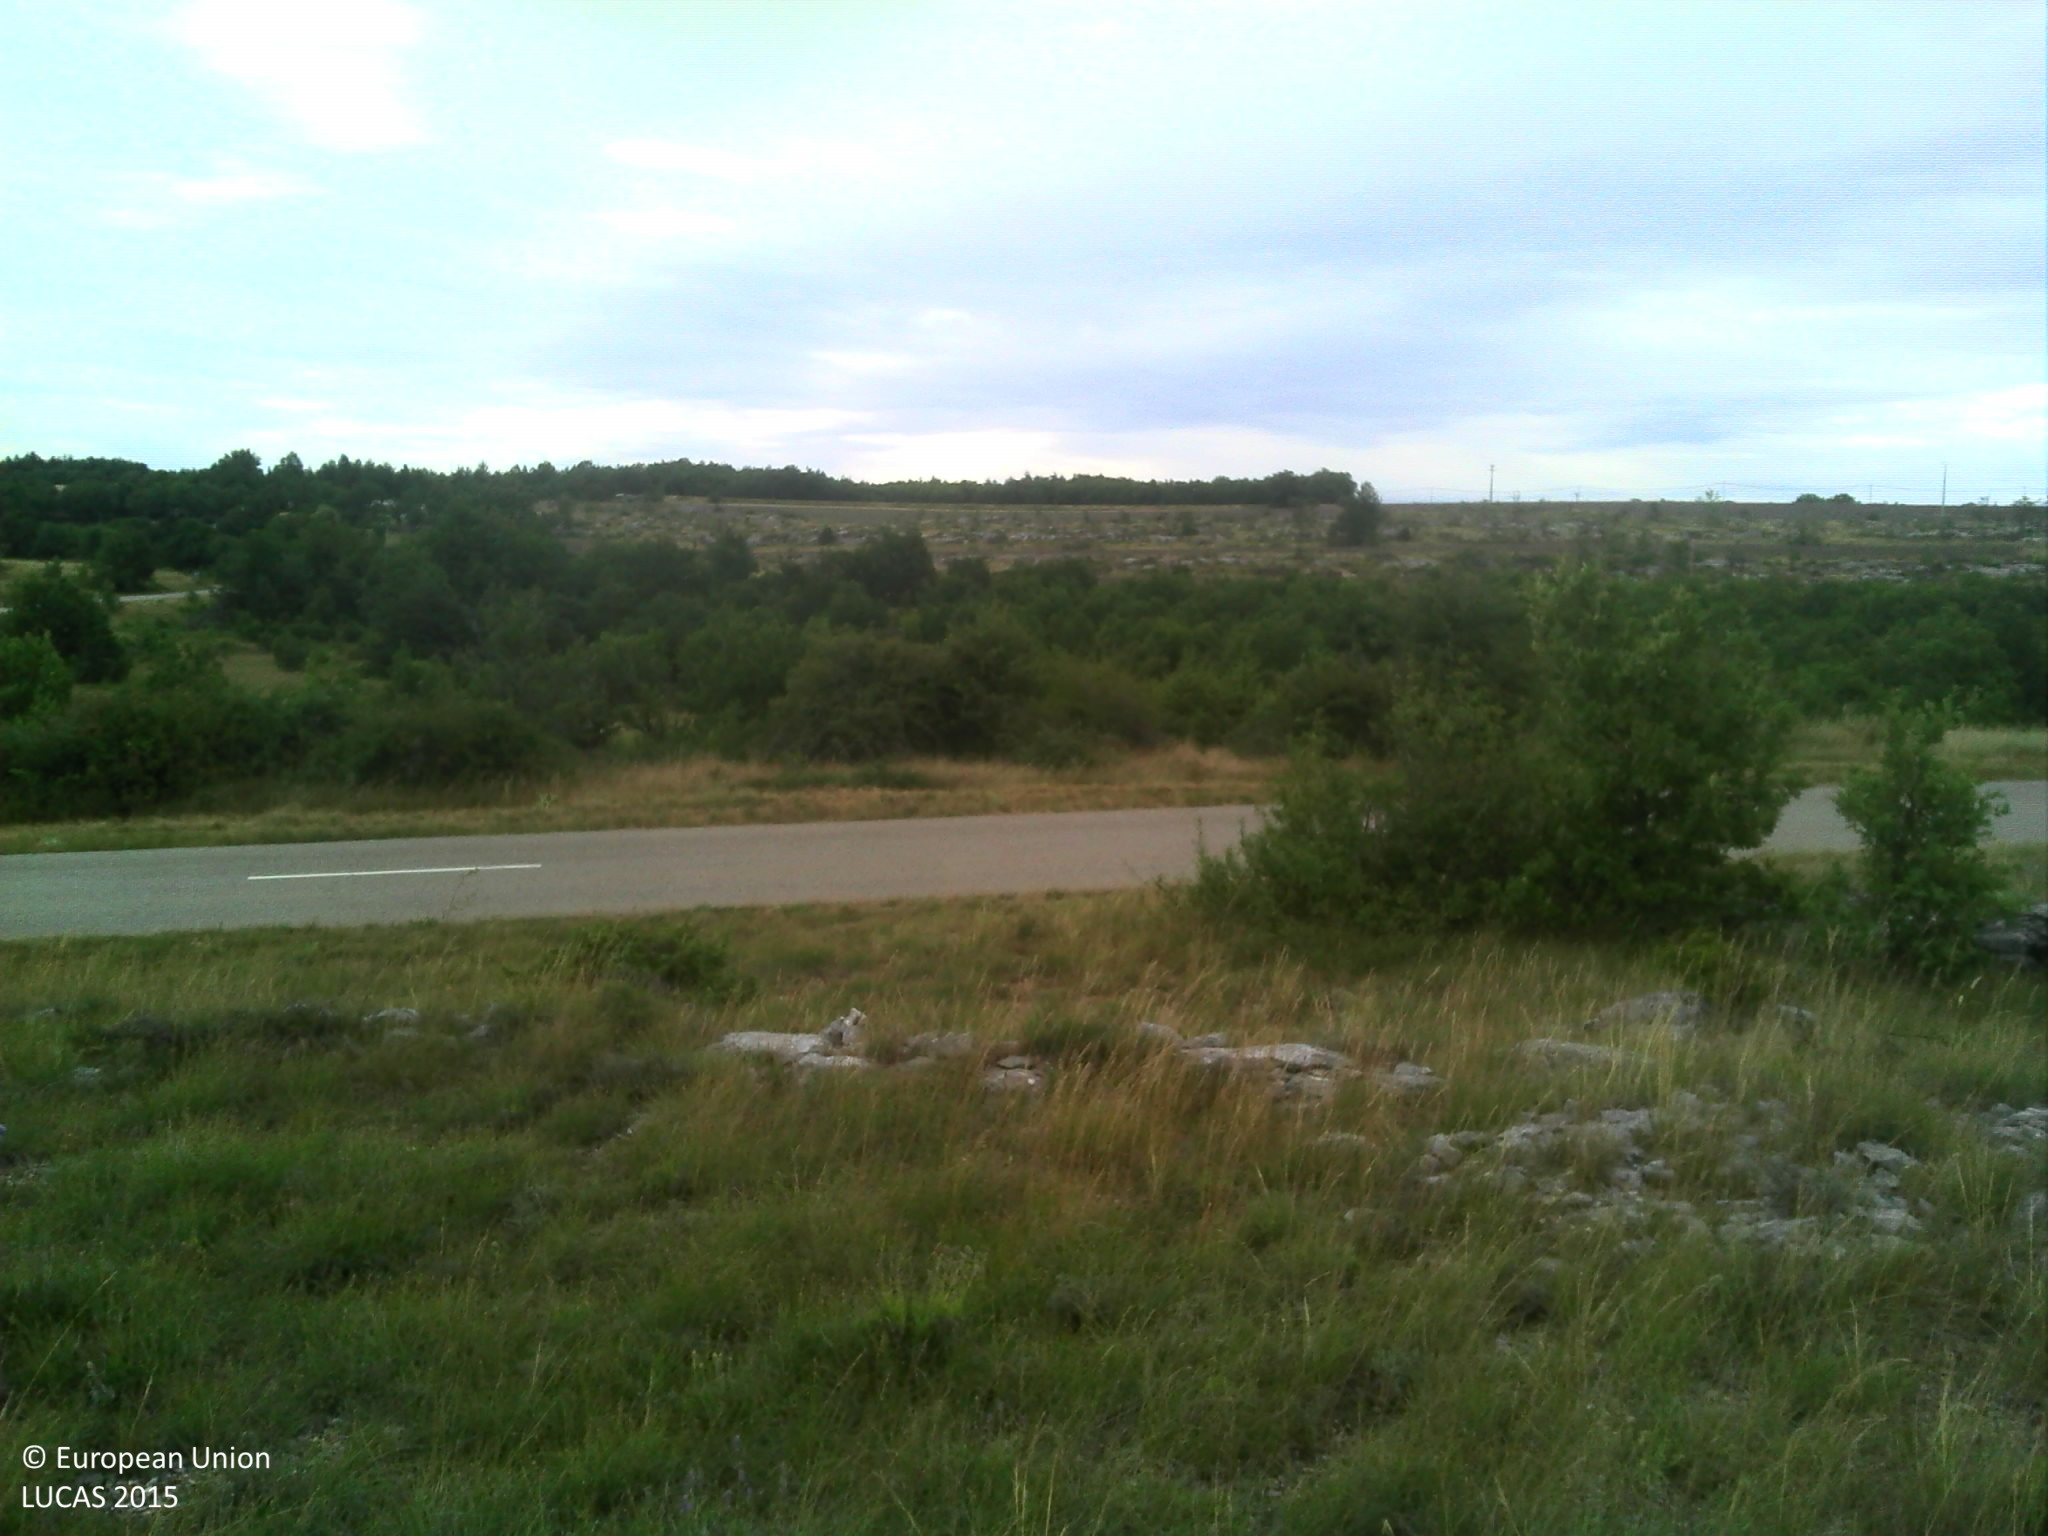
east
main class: Grassland
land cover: Grassland with sparse tree/shrub cover
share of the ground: > 75 %
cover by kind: herbaceous plants 75 %, consolidated bare surface 15 %, coniferous forest trees 5 %, shrubs 5 %
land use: Semi-natural and natural areas not in use
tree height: < 5 m
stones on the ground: 25 - 50 %
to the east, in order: Grassland with sparse tree/shrub cover; Rock outcrops; Grassland with sparse tree/shrub cover; Grass margins; Paved roads, cycling and walking lanes; Grass margins; Shrubland with sparse tree cover; Broadleaved woodland; Grassland without tree/shrub cover; Shrubland with sparse tree cover
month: July
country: FR
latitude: 44.0014
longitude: 5.5311
